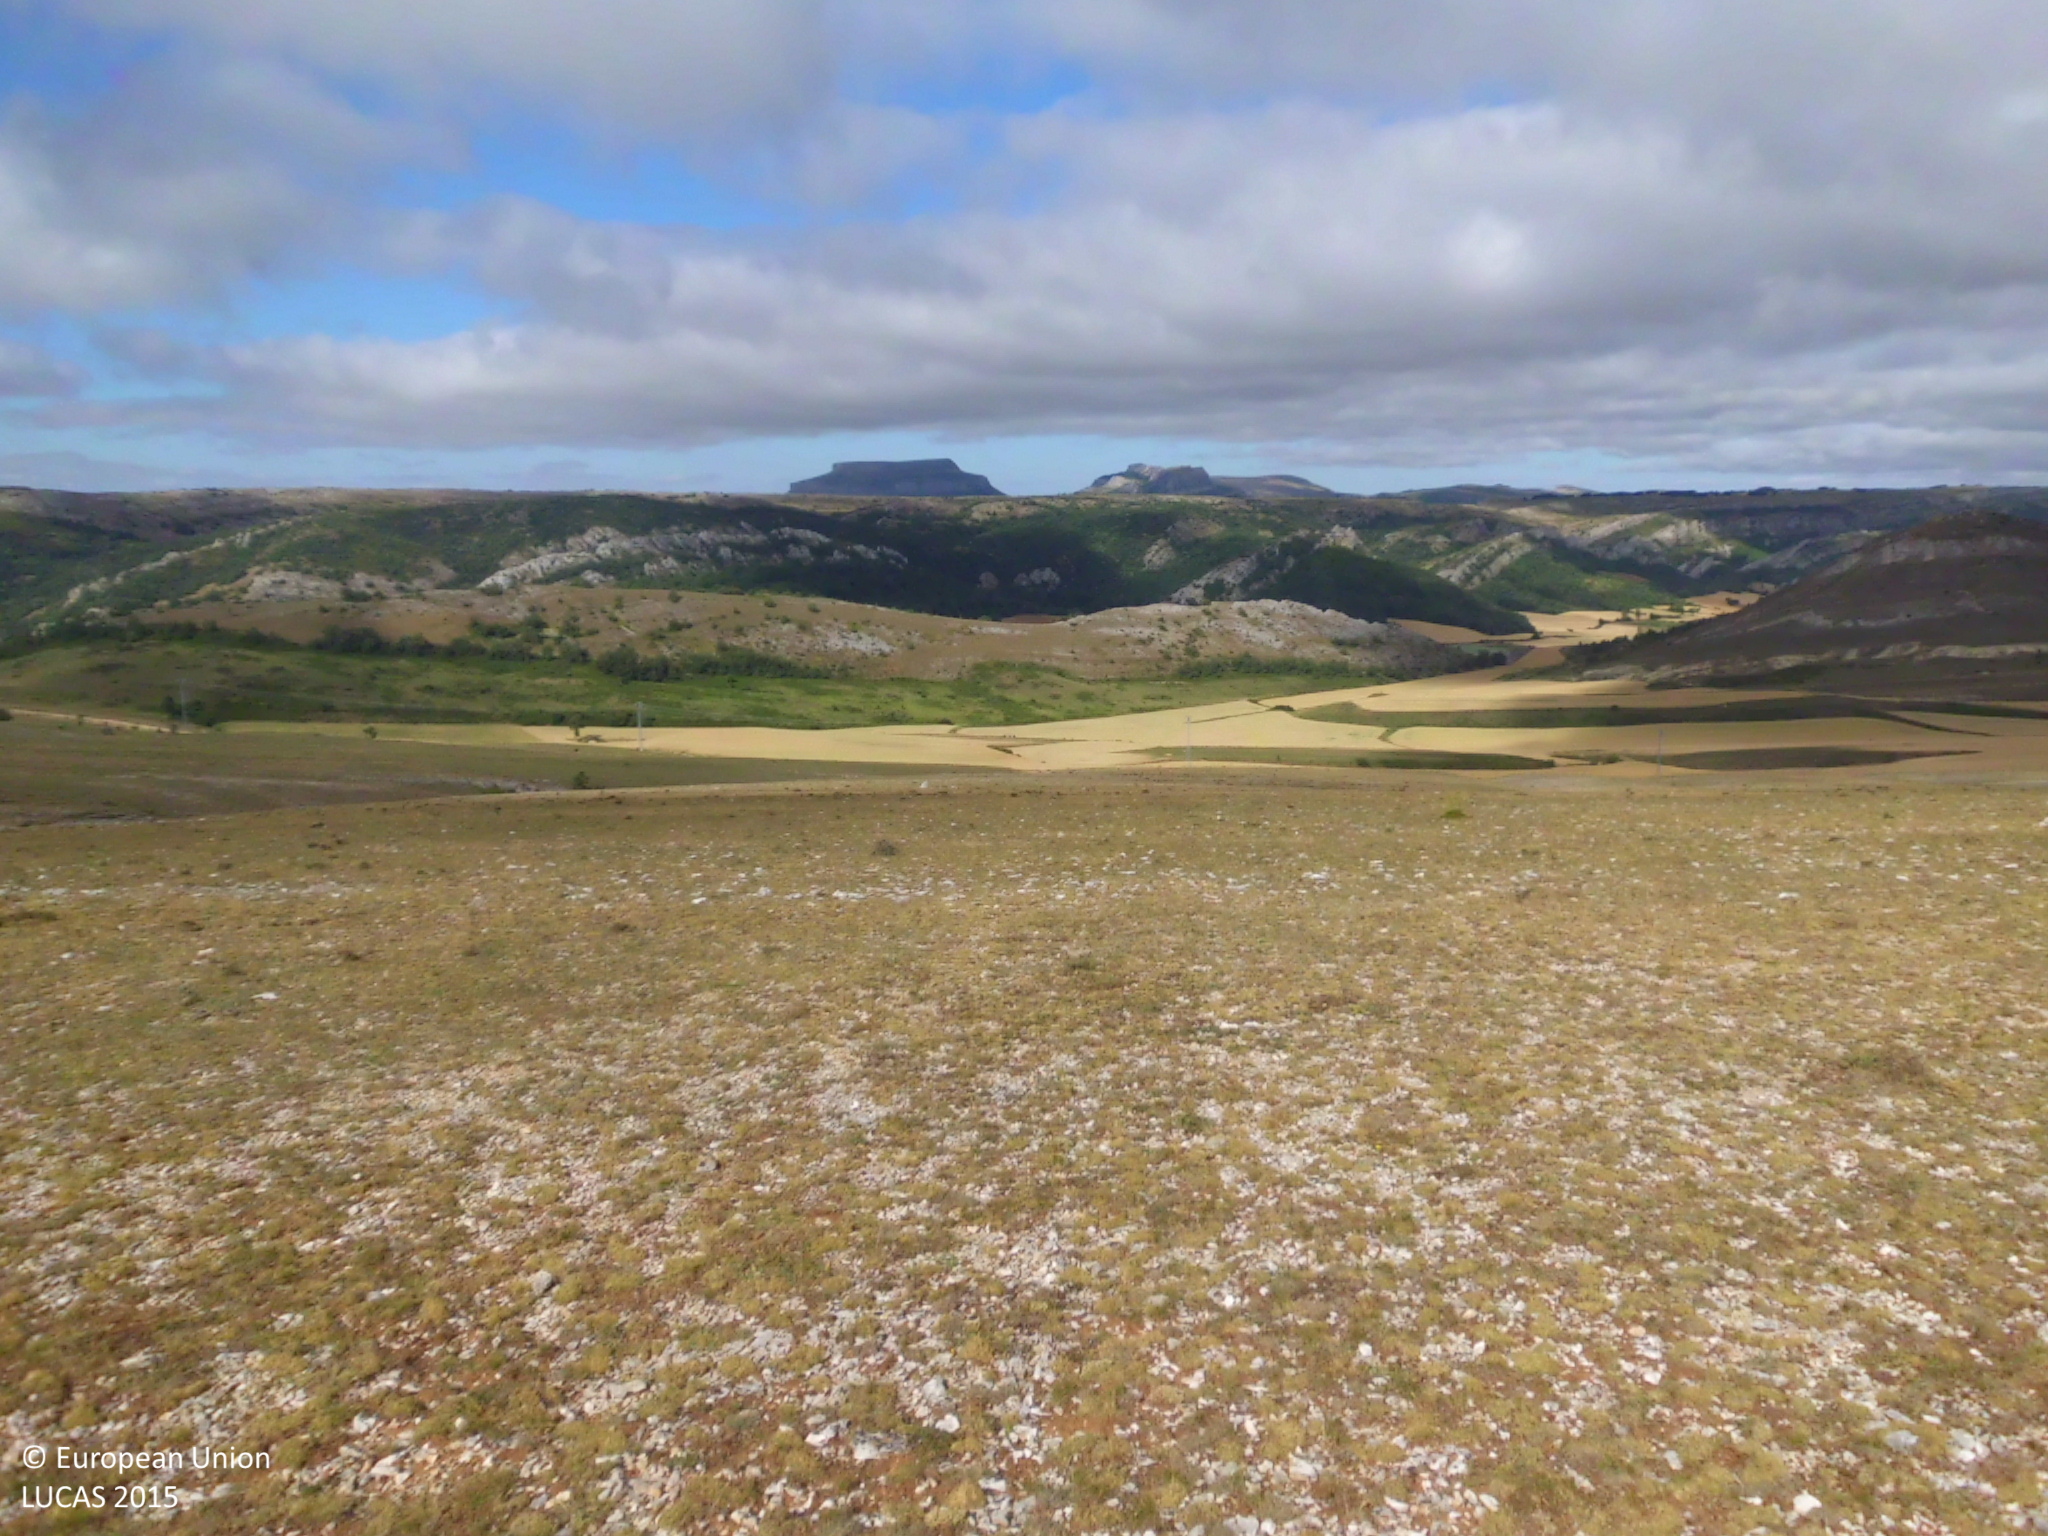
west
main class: Grassland
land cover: Grassland without tree/shrub cover
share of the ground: 50 - 75 %
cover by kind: herbaceous plants 50 %, consolidated bare surface 50 %
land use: Agriculture (excluding fallow land and kitchen gardens)
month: July
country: ES
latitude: 42.6946
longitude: -4.0462
